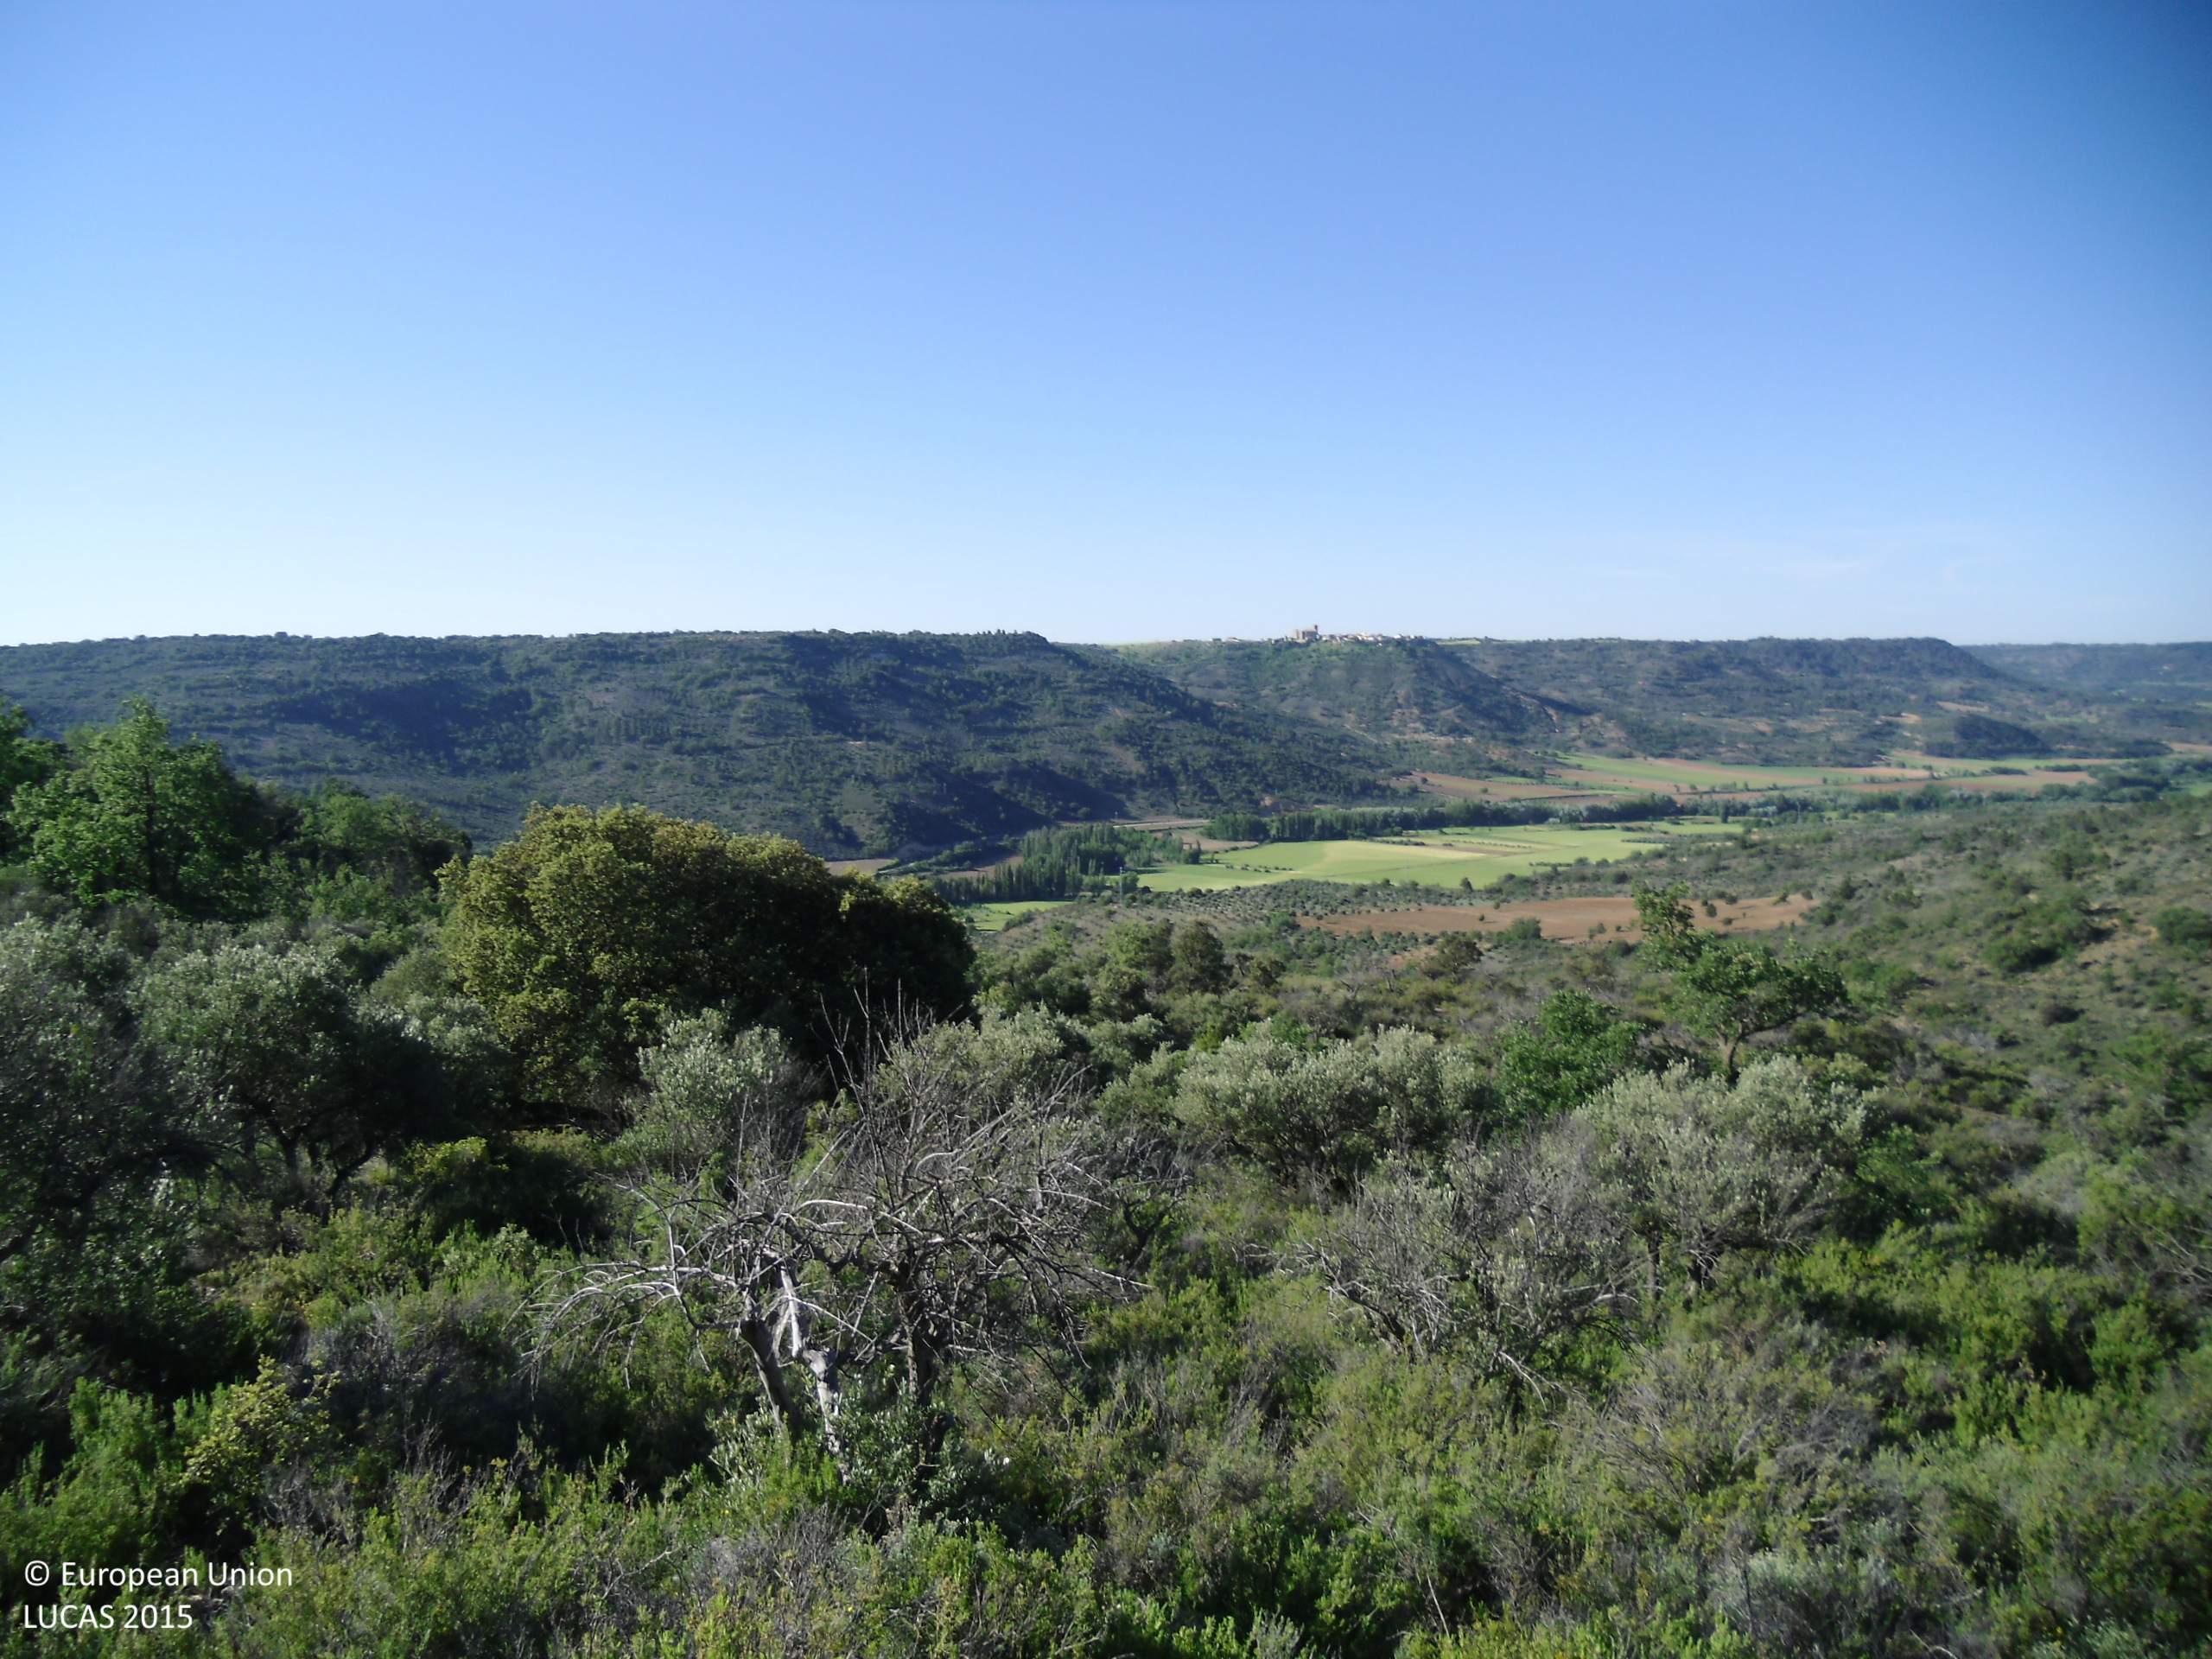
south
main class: Cropland
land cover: Olive groves
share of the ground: 25 - 50 %
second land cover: Shrubland without tree cover
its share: > 75 %
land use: Abandoned areas
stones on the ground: 10 - 25 %
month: May
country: ES
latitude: 40.6482
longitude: -2.9567
